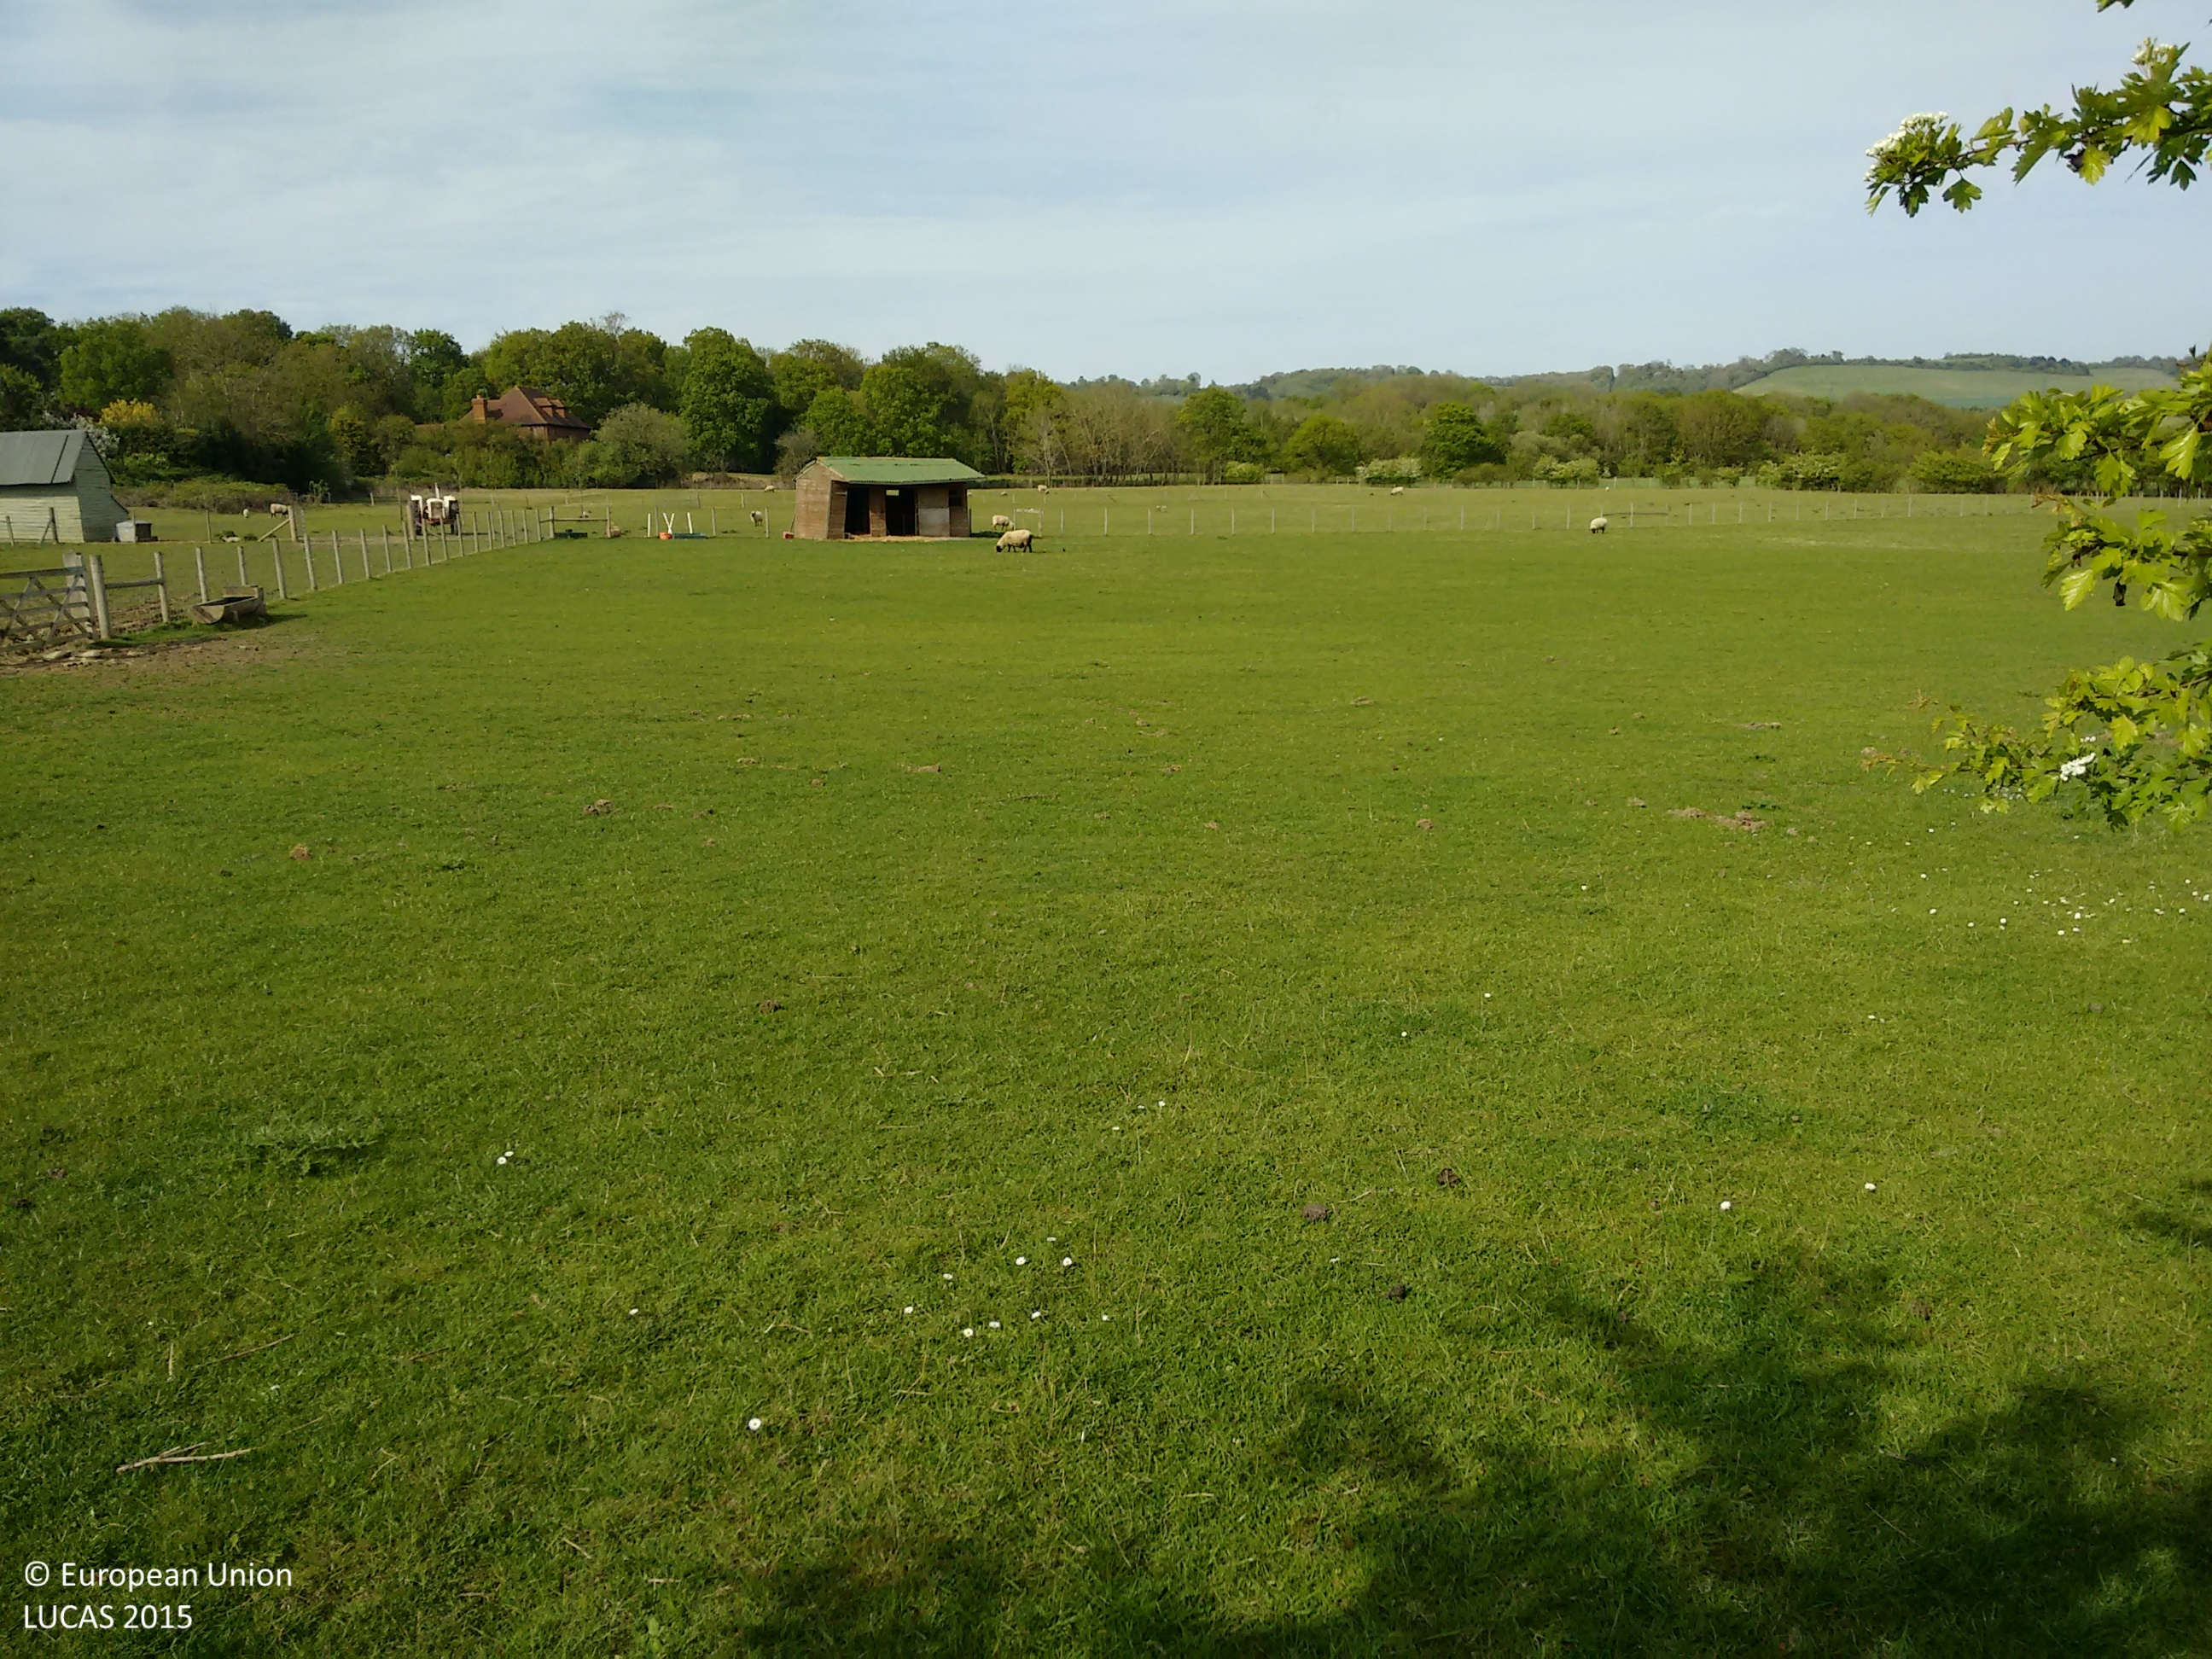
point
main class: Grassland
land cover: Grassland without tree/shrub cover
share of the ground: > 75 %
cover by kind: herbaceous plants 100 %
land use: Agriculture (excluding fallow land and kitchen gardens)
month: May
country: GB
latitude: 51.2783
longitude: 0.5829
